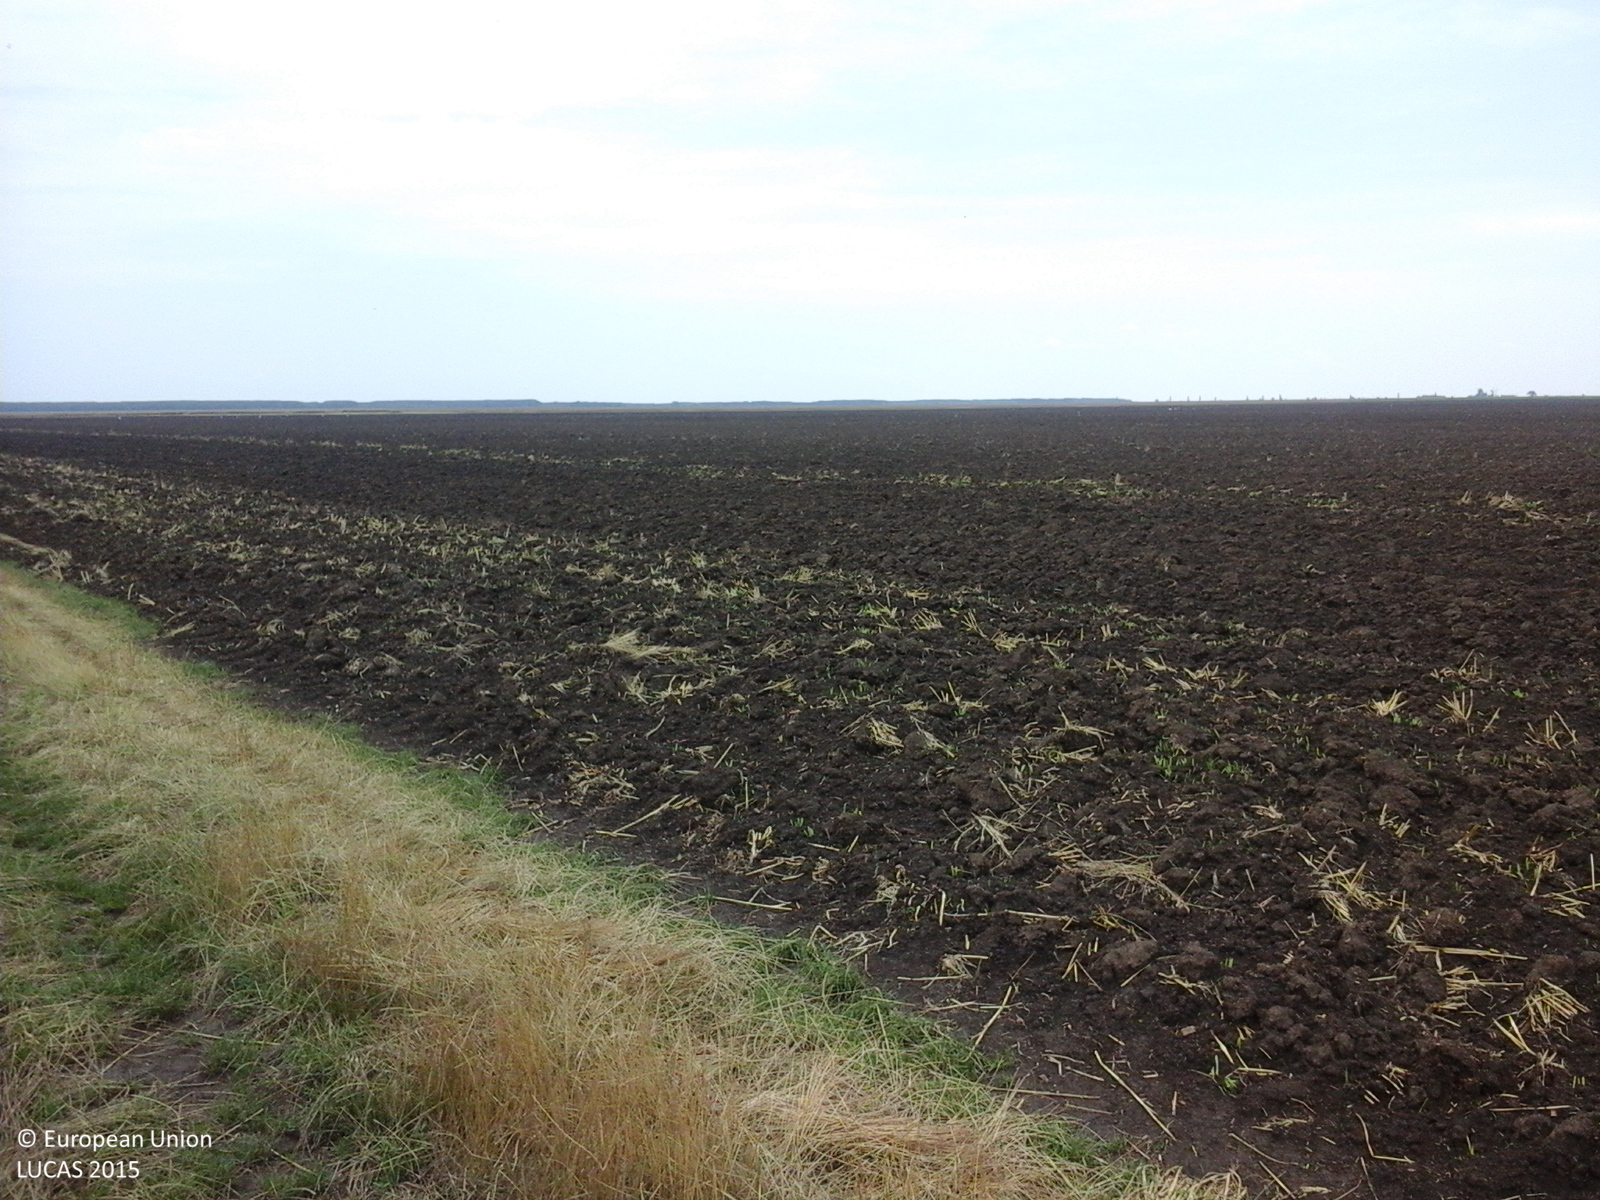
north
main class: Cropland
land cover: Sunflower
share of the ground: > 75 %
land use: Agriculture (excluding fallow land and kitchen gardens)
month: July
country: RO
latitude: 44.0007
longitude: 25.8710
